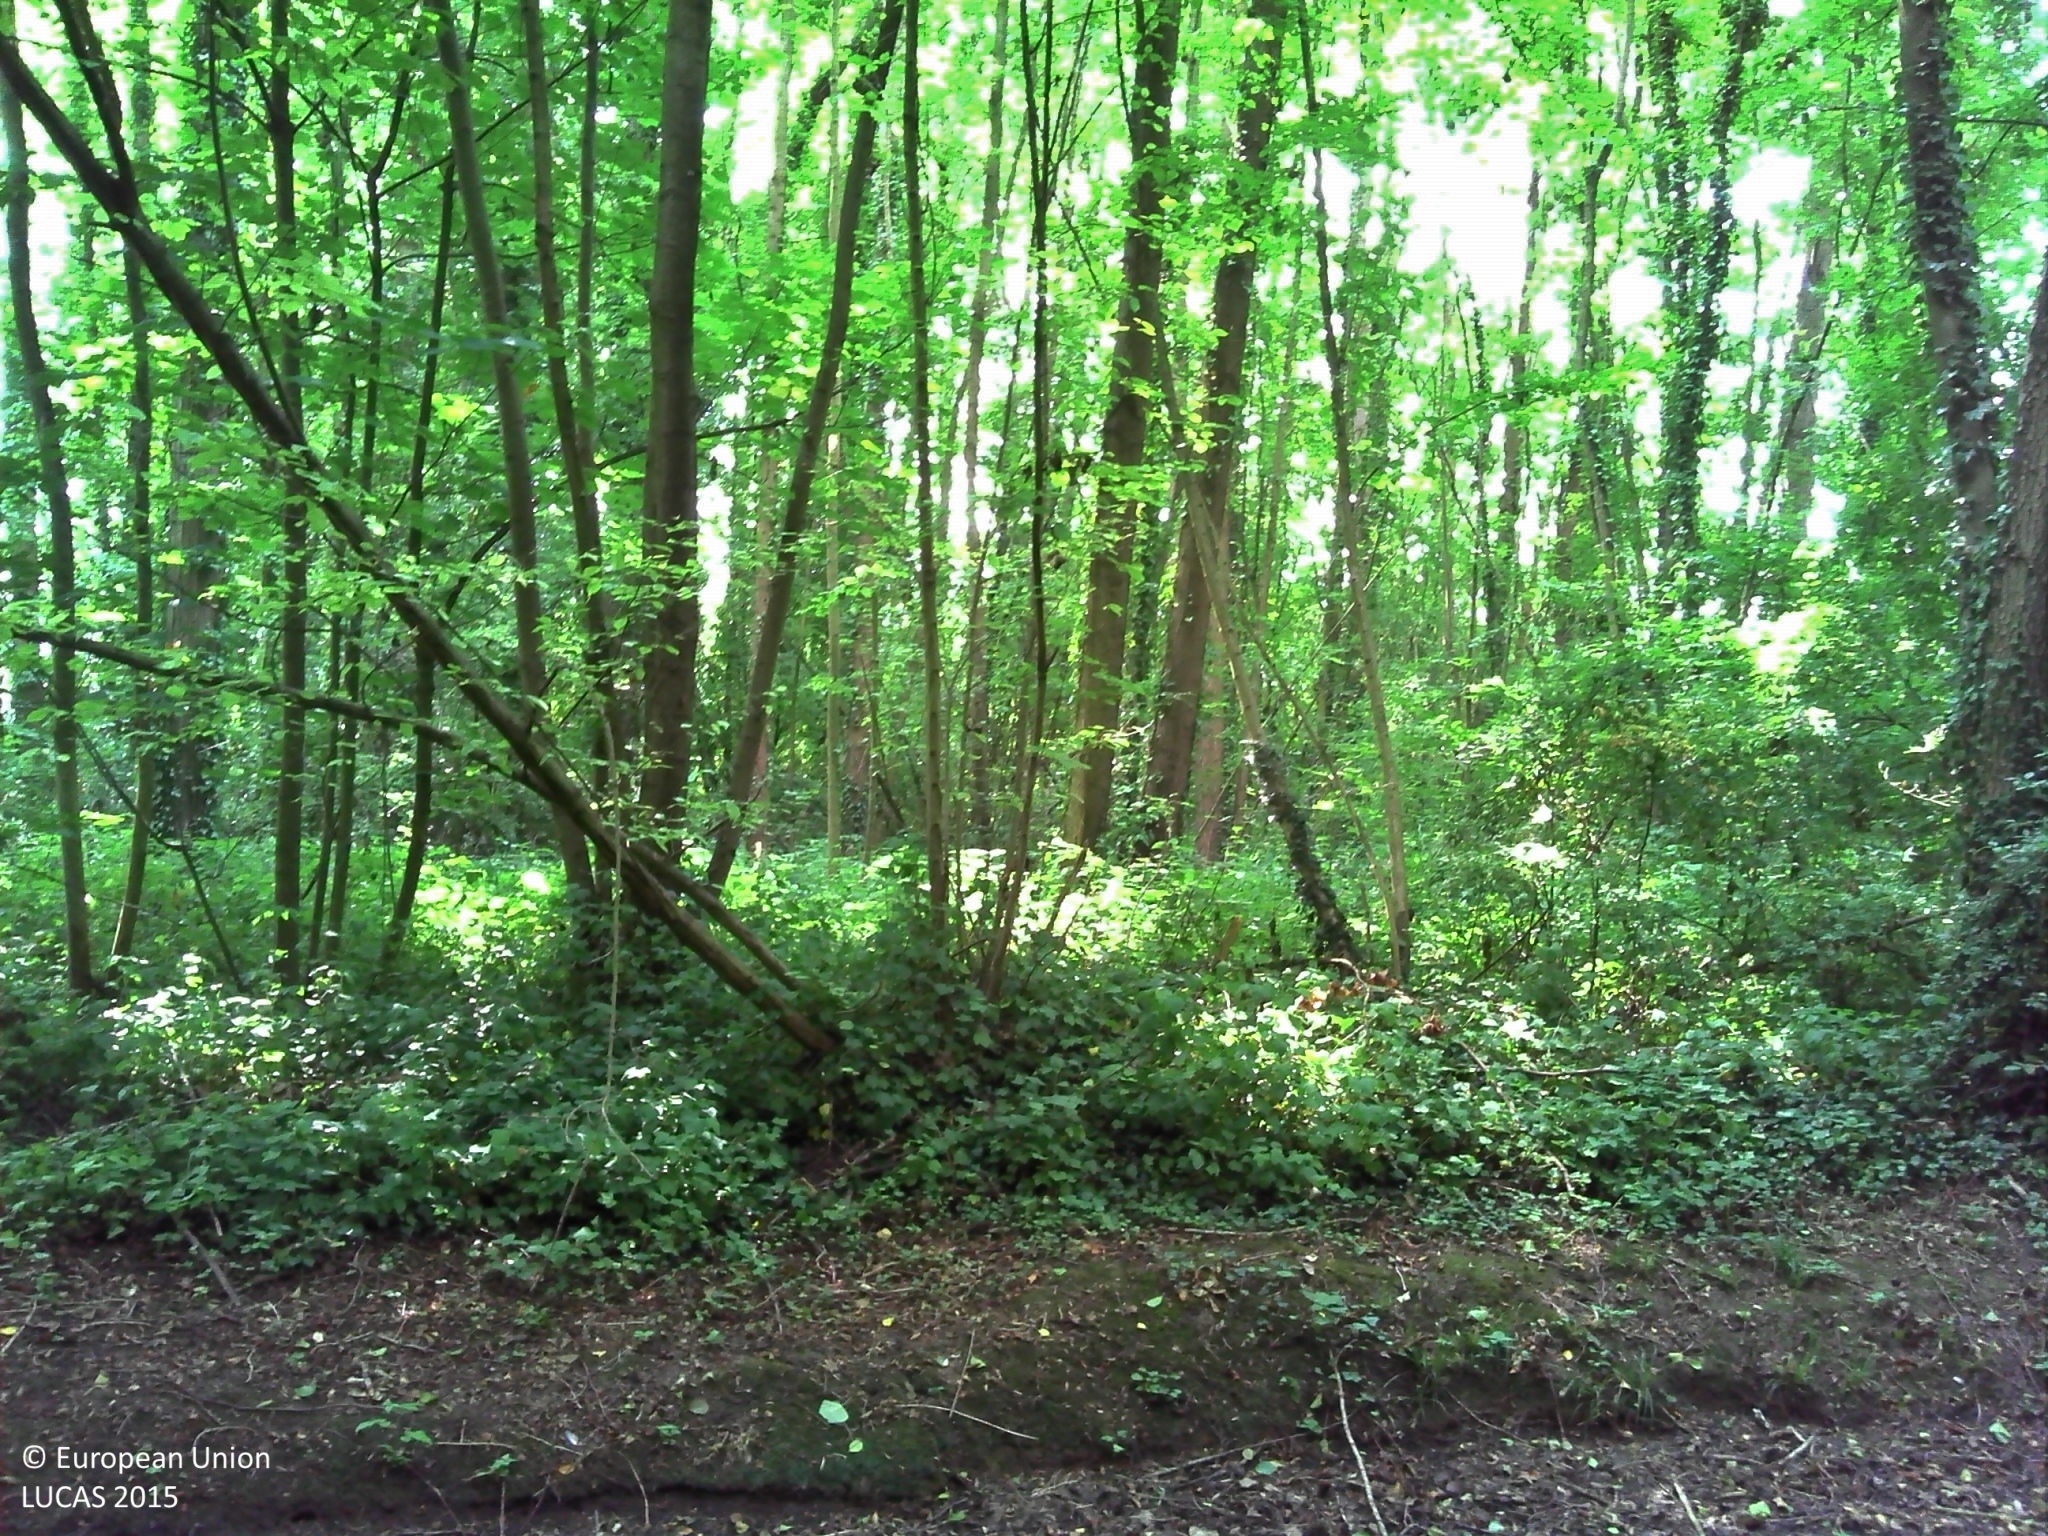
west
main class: Woodland
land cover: Broadleaved woodland
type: acidophilous oak and oak-birch forest
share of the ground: > 75 %
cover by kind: broadleaved forest trees 75 %, shrubs 10 %, herbaceous plants 10 %, unconsolidated bare surface 5 %
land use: Forestry
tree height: > 5 m
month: July
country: FR
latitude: 49.2076
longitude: 2.3972
